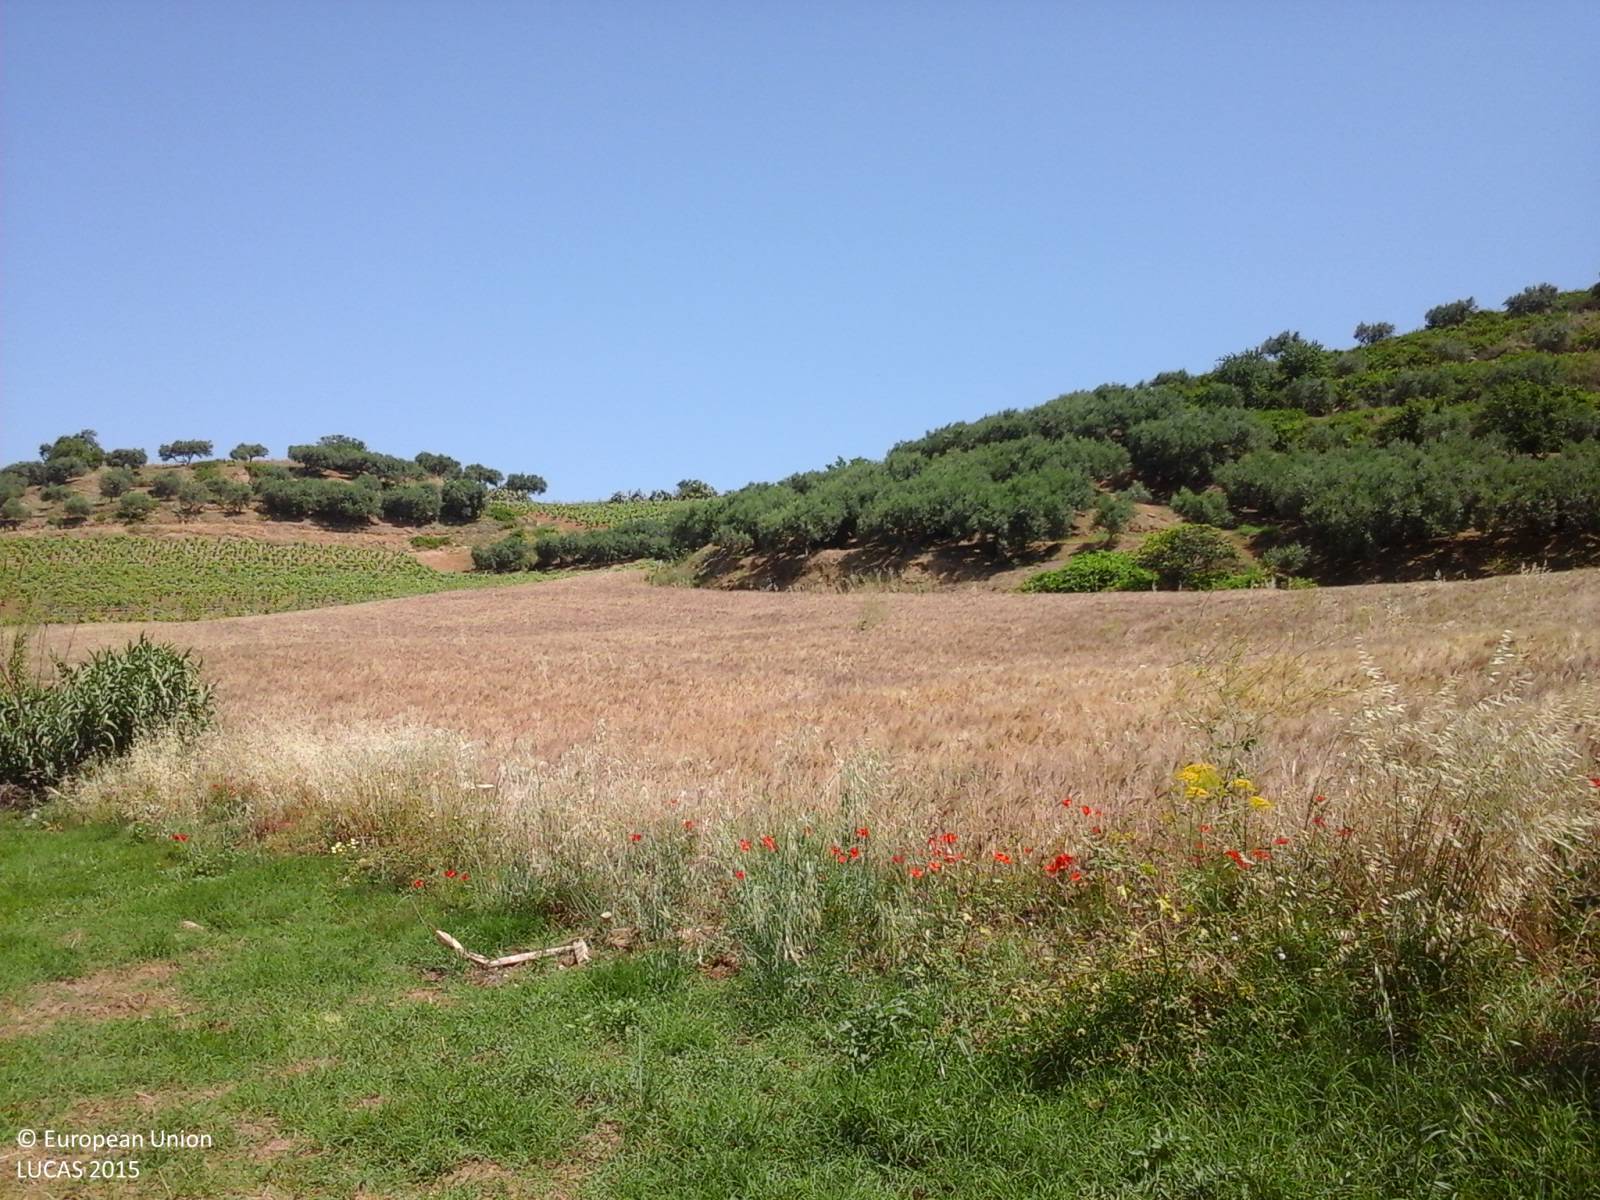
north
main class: Grassland
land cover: Spontaneously vegetated surfaces
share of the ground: > 75 %
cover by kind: herbaceous plants 100 %
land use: Agriculture (excluding fallow land and kitchen gardens)
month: June
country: IT
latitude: 37.9359
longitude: 13.0161
